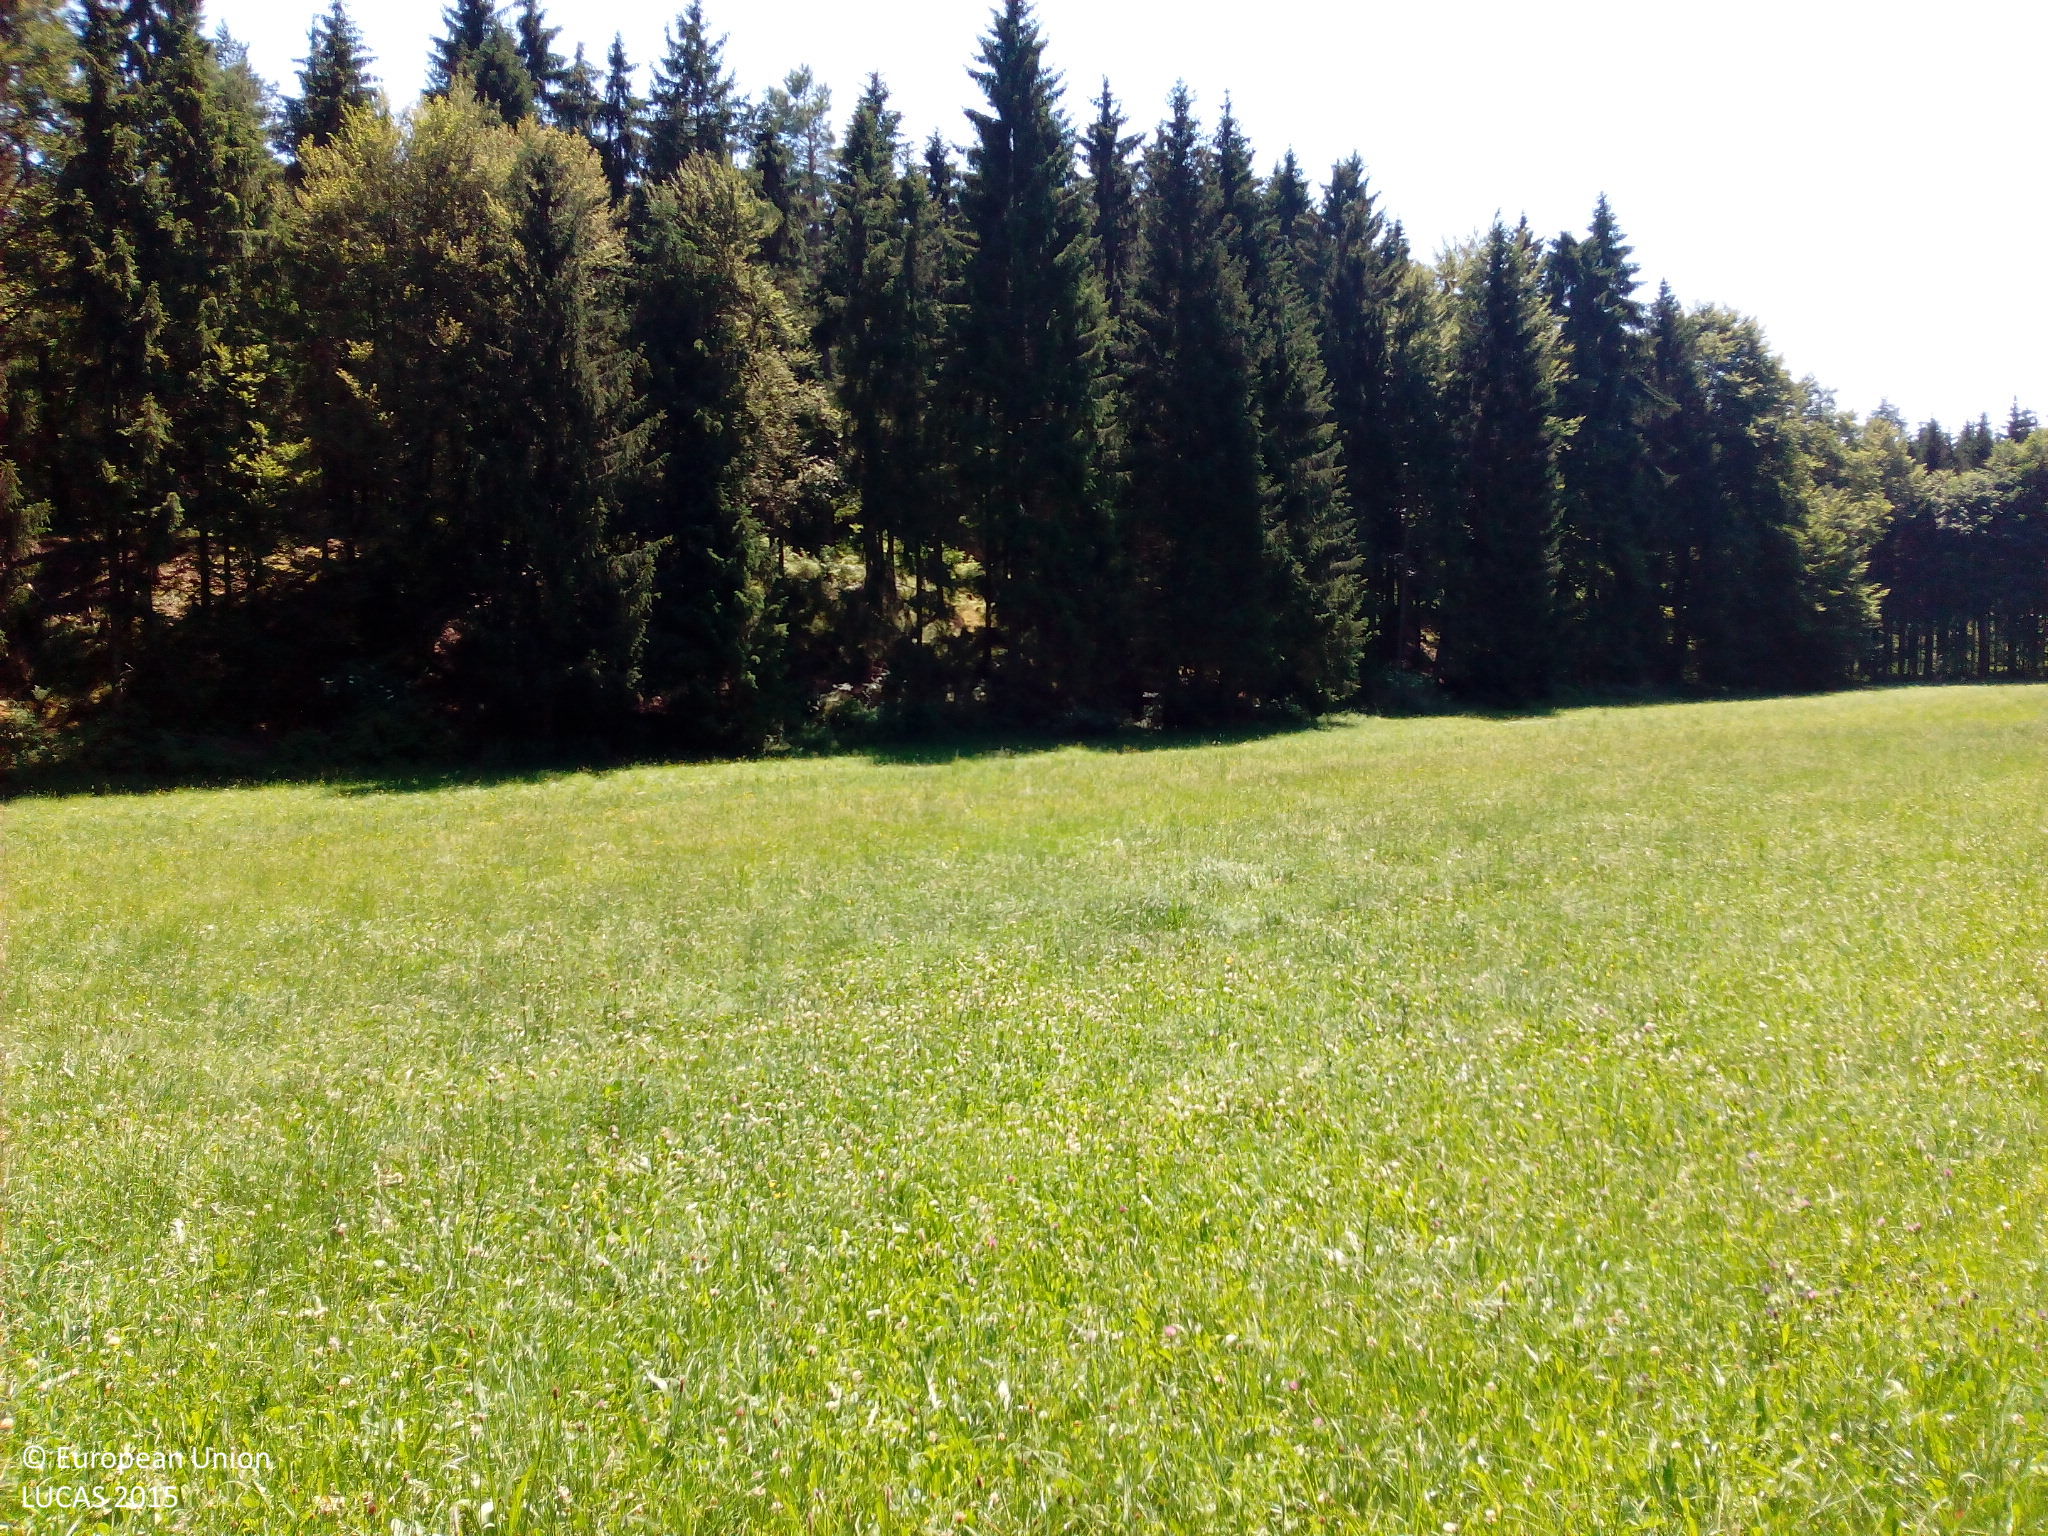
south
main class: Shrubland
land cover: Shrubland with sparse tree cover
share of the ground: 25 - 50 %
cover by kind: herbaceous plants 60 %, shrubs 35 %, coniferous forest trees 5 %
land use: Agriculture (excluding fallow land and kitchen gardens)
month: July
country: DE
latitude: 48.3478
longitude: 9.3932
